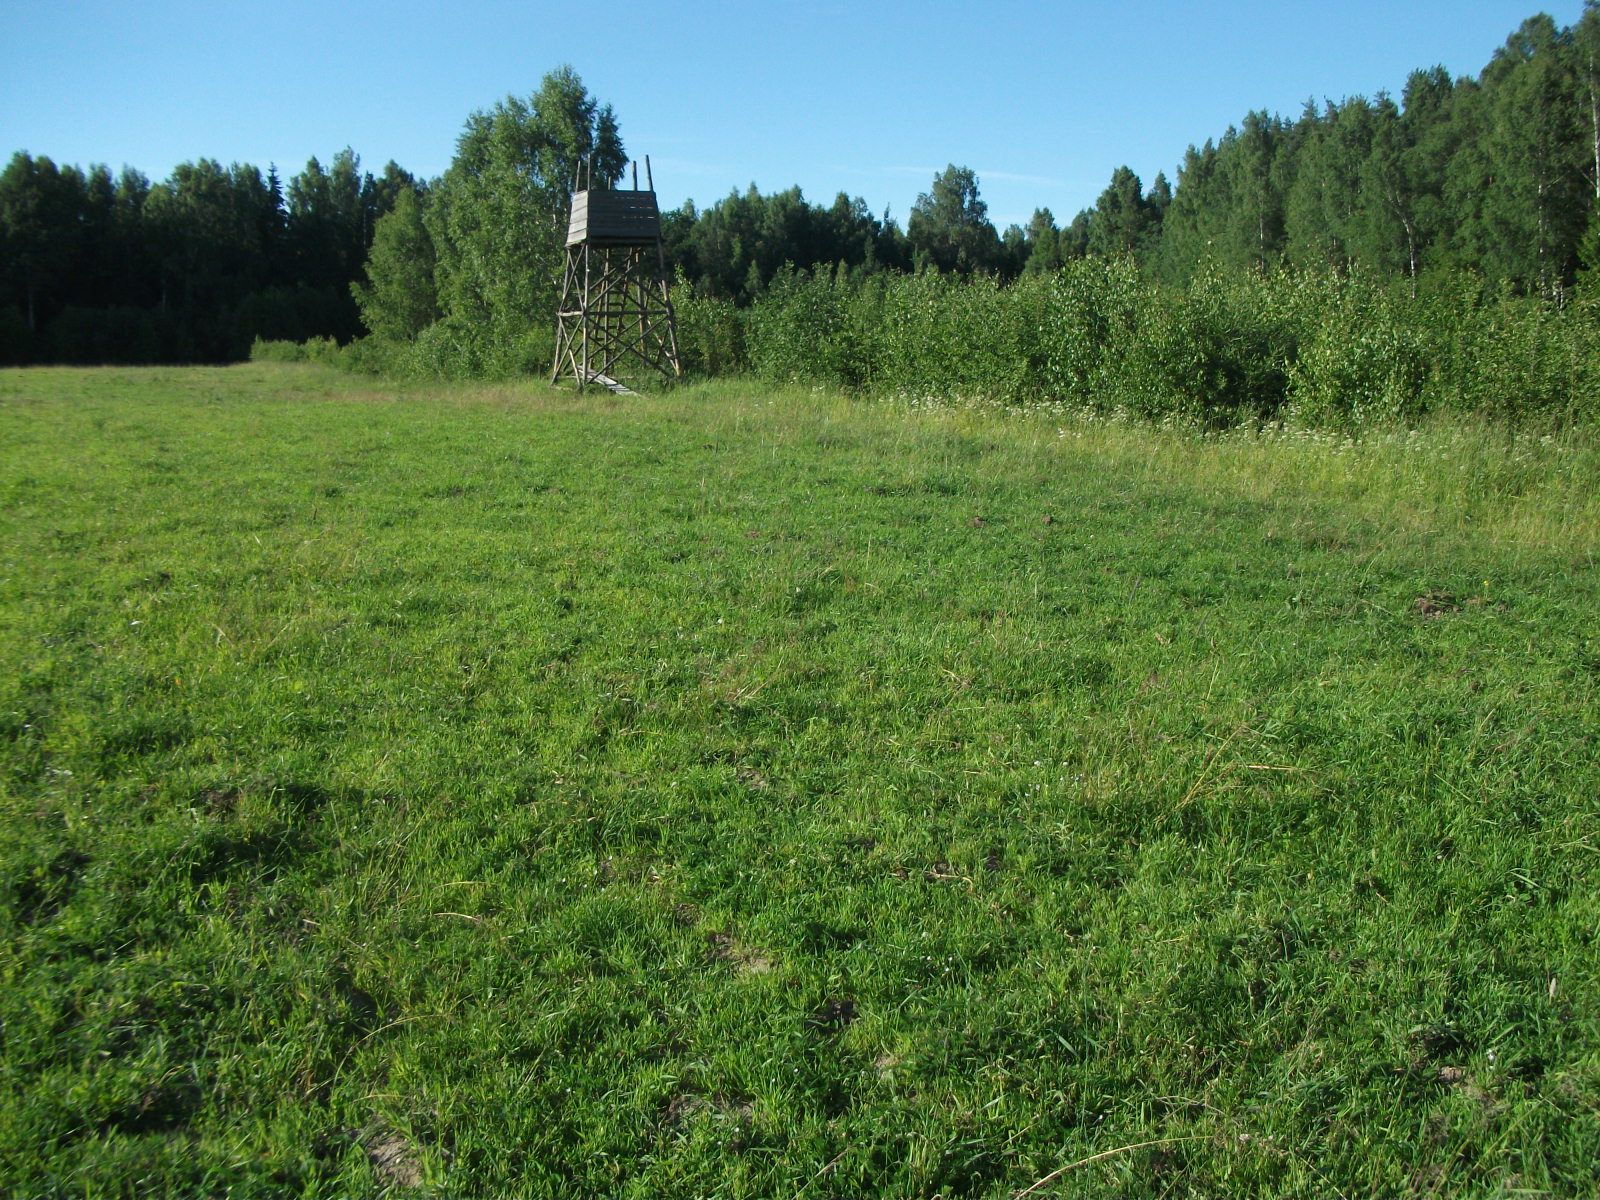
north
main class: Grassland
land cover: Grassland without tree/shrub cover
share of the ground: > 75 %
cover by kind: herbaceous plants 100 %
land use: Agriculture (excluding fallow land and kitchen gardens)
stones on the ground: < 10 %
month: July
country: LV
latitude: 56.8081
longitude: 26.3062
